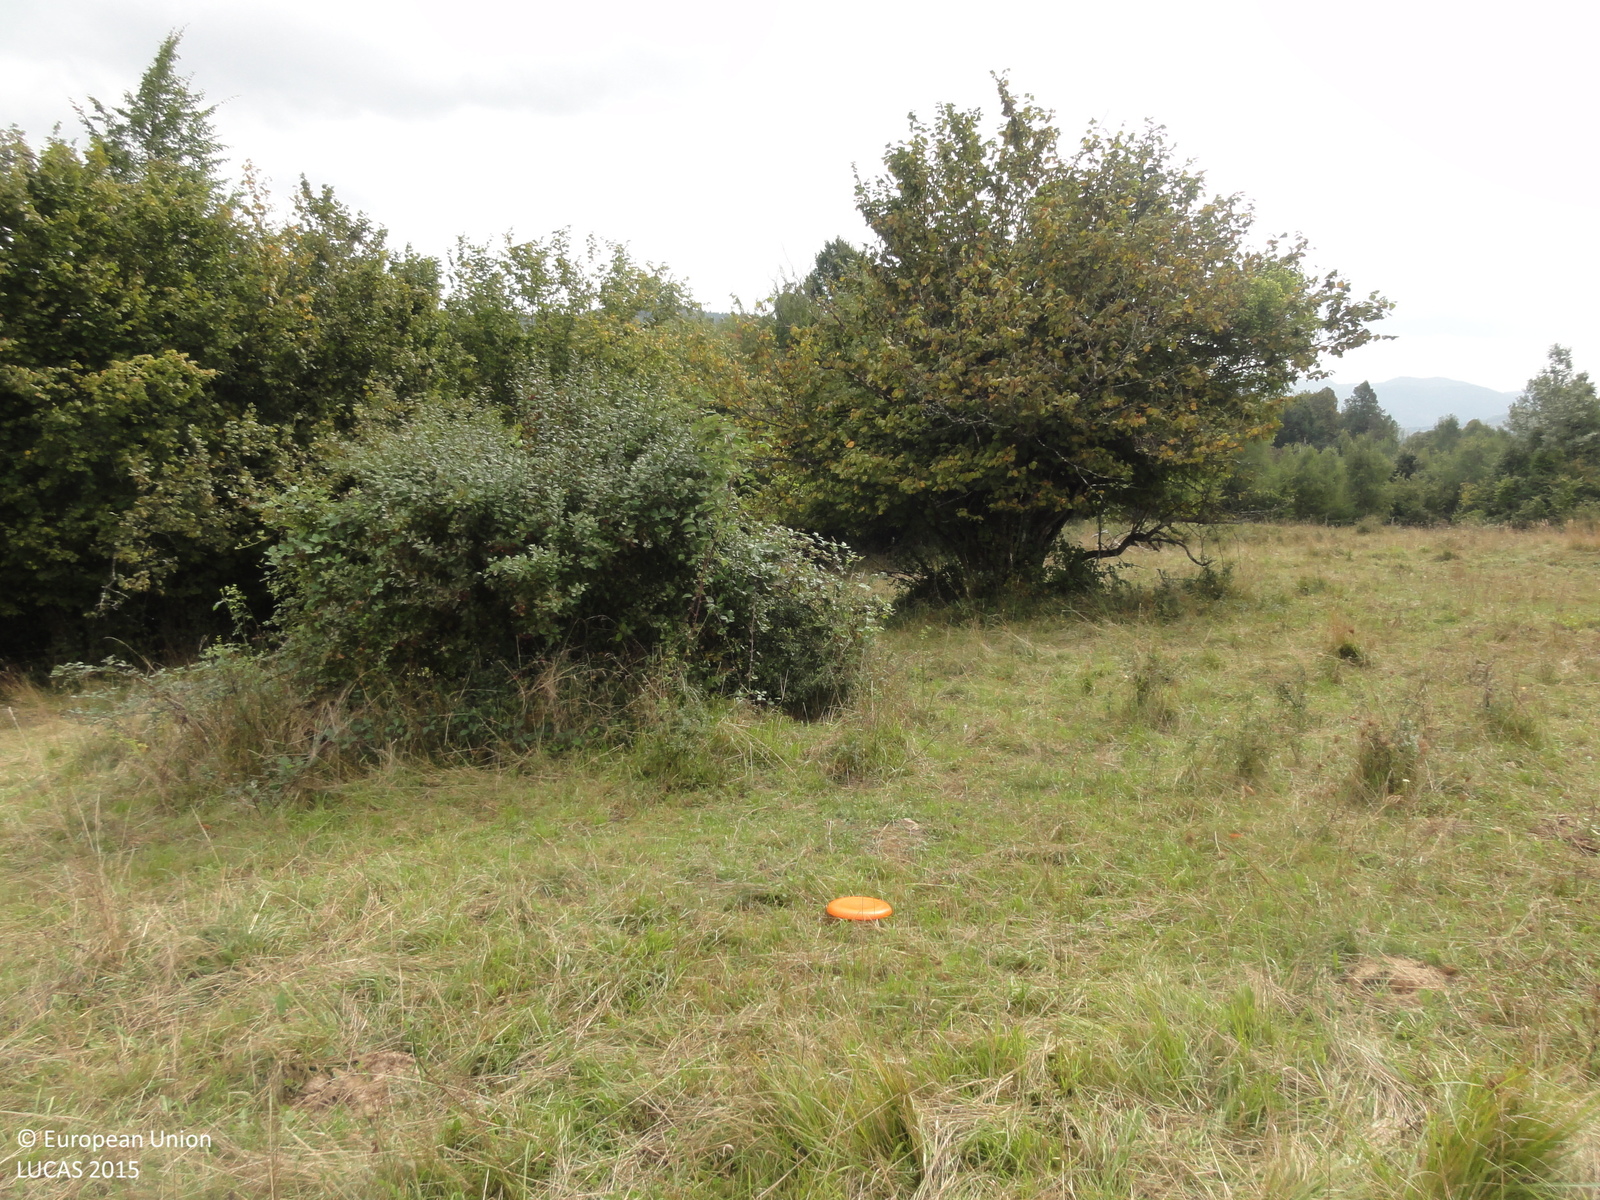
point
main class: Grassland
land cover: Grassland with sparse tree/shrub cover
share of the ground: > 75 %
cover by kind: herbaceous plants 90 %, broadleaved forest trees 5 %, shrubs 5 %
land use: Agriculture (excluding fallow land and kitchen gardens)
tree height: > 5 m
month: September
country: SI
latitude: 45.5830
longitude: 15.0328
